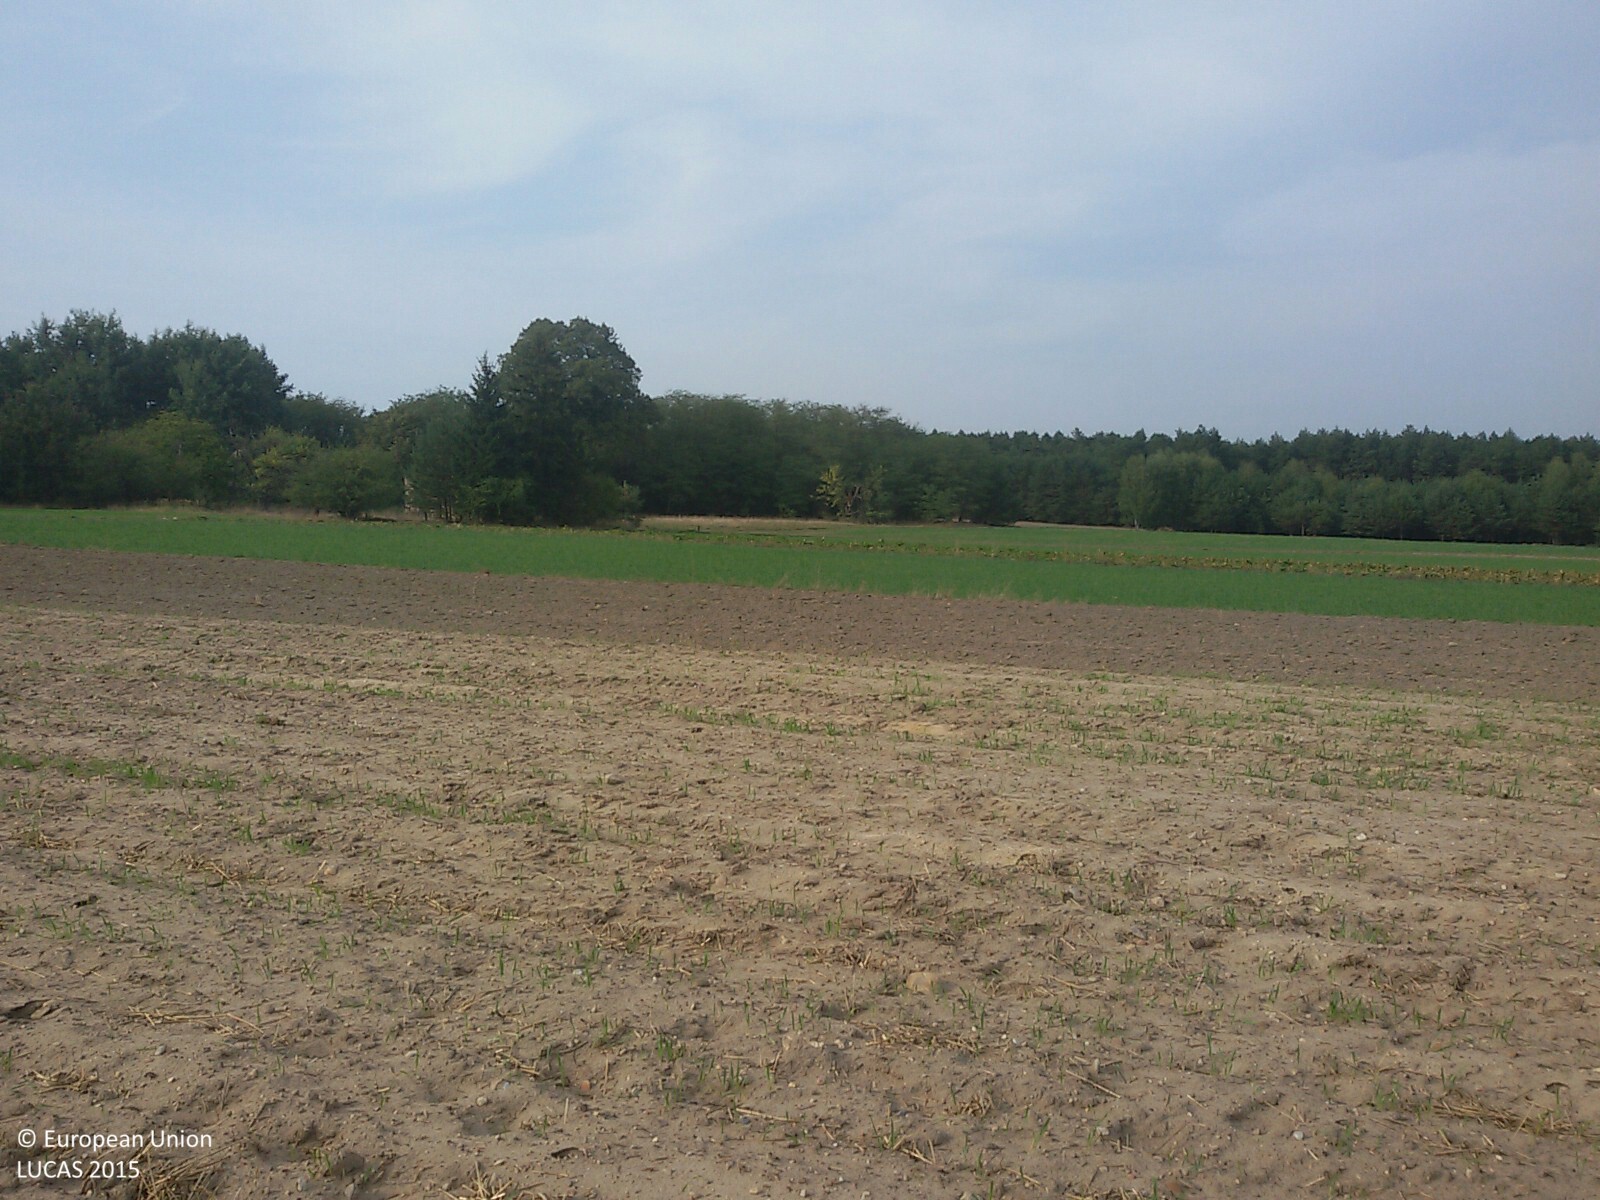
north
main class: Cropland
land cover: Rye
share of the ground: < 10 %
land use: Agriculture (excluding fallow land and kitchen gardens)
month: September
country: PL
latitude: 51.2162
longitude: 18.8266
